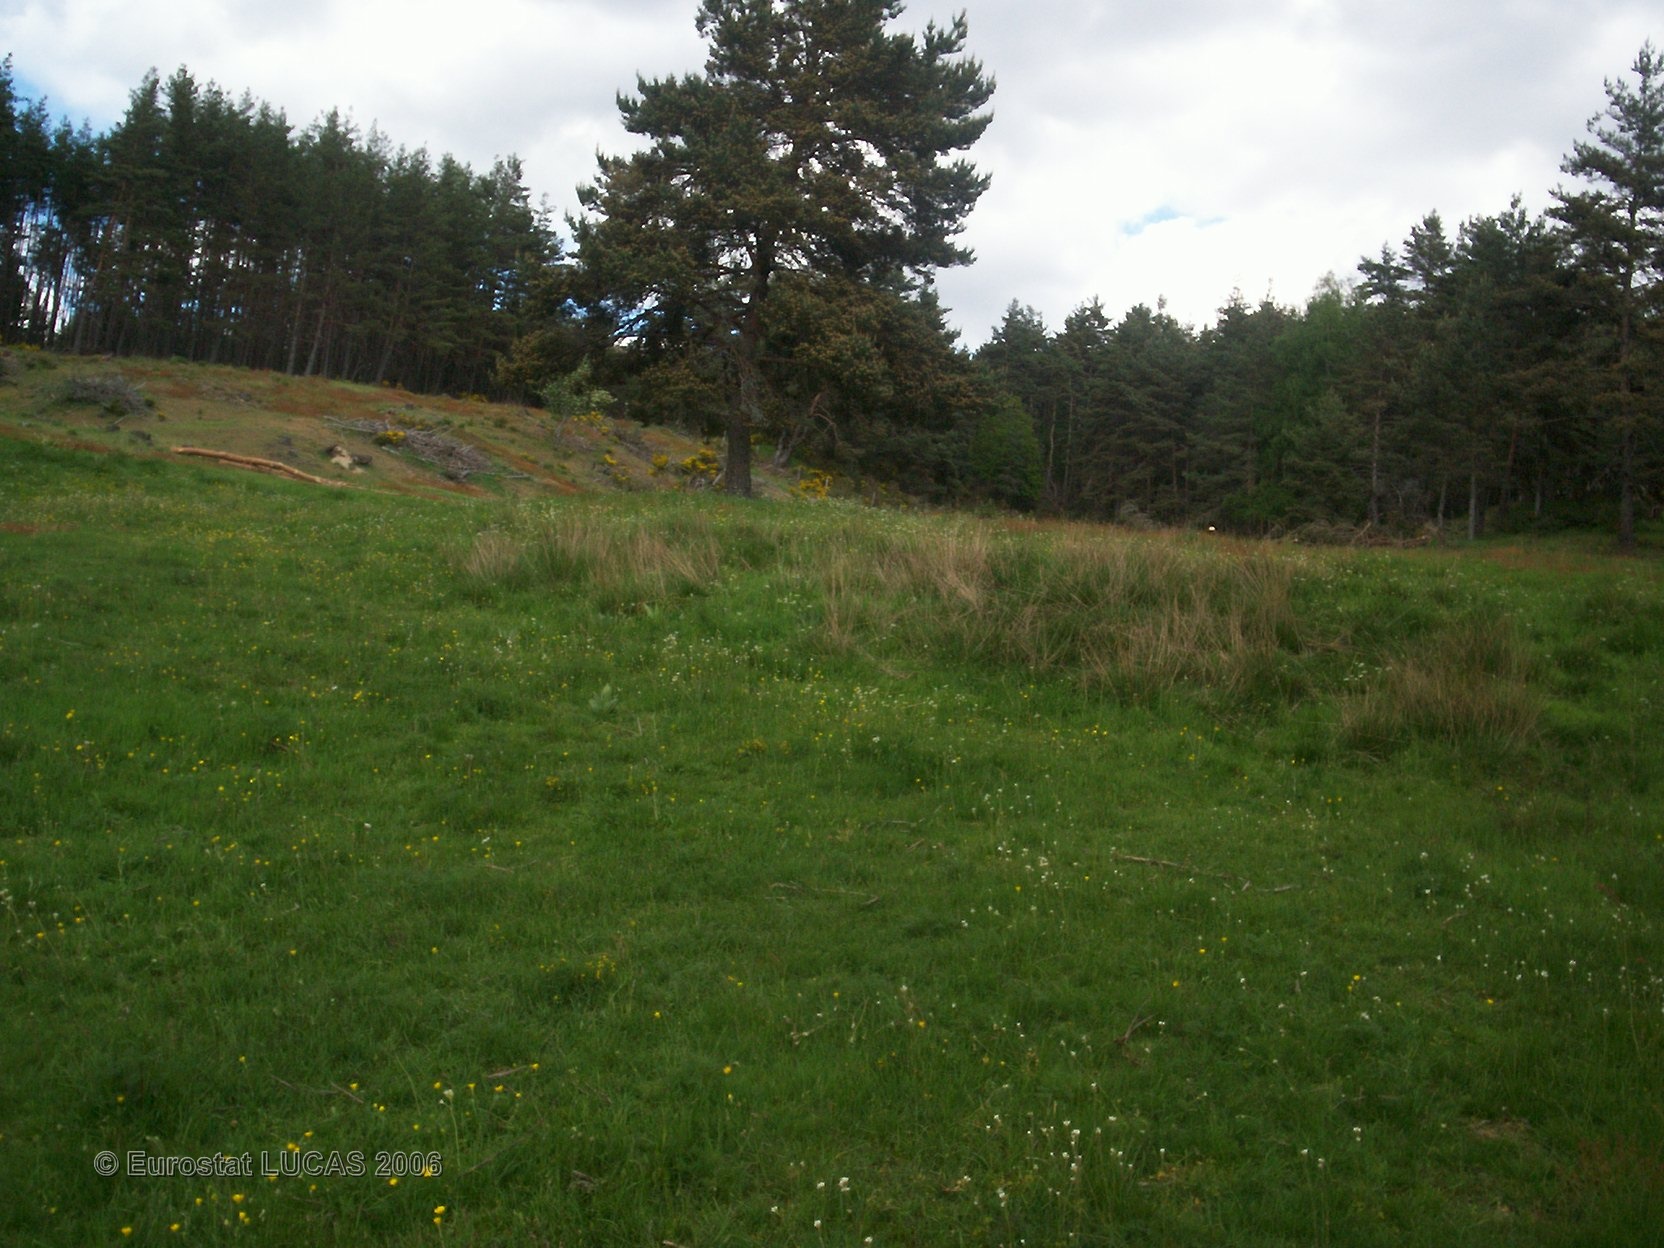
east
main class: Grassland
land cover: Grassland with sparse tree/shrub cover
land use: Agriculture (excluding fallow land and kitchen gardens)
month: May
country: FR
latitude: 44.7520
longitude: 3.3472
